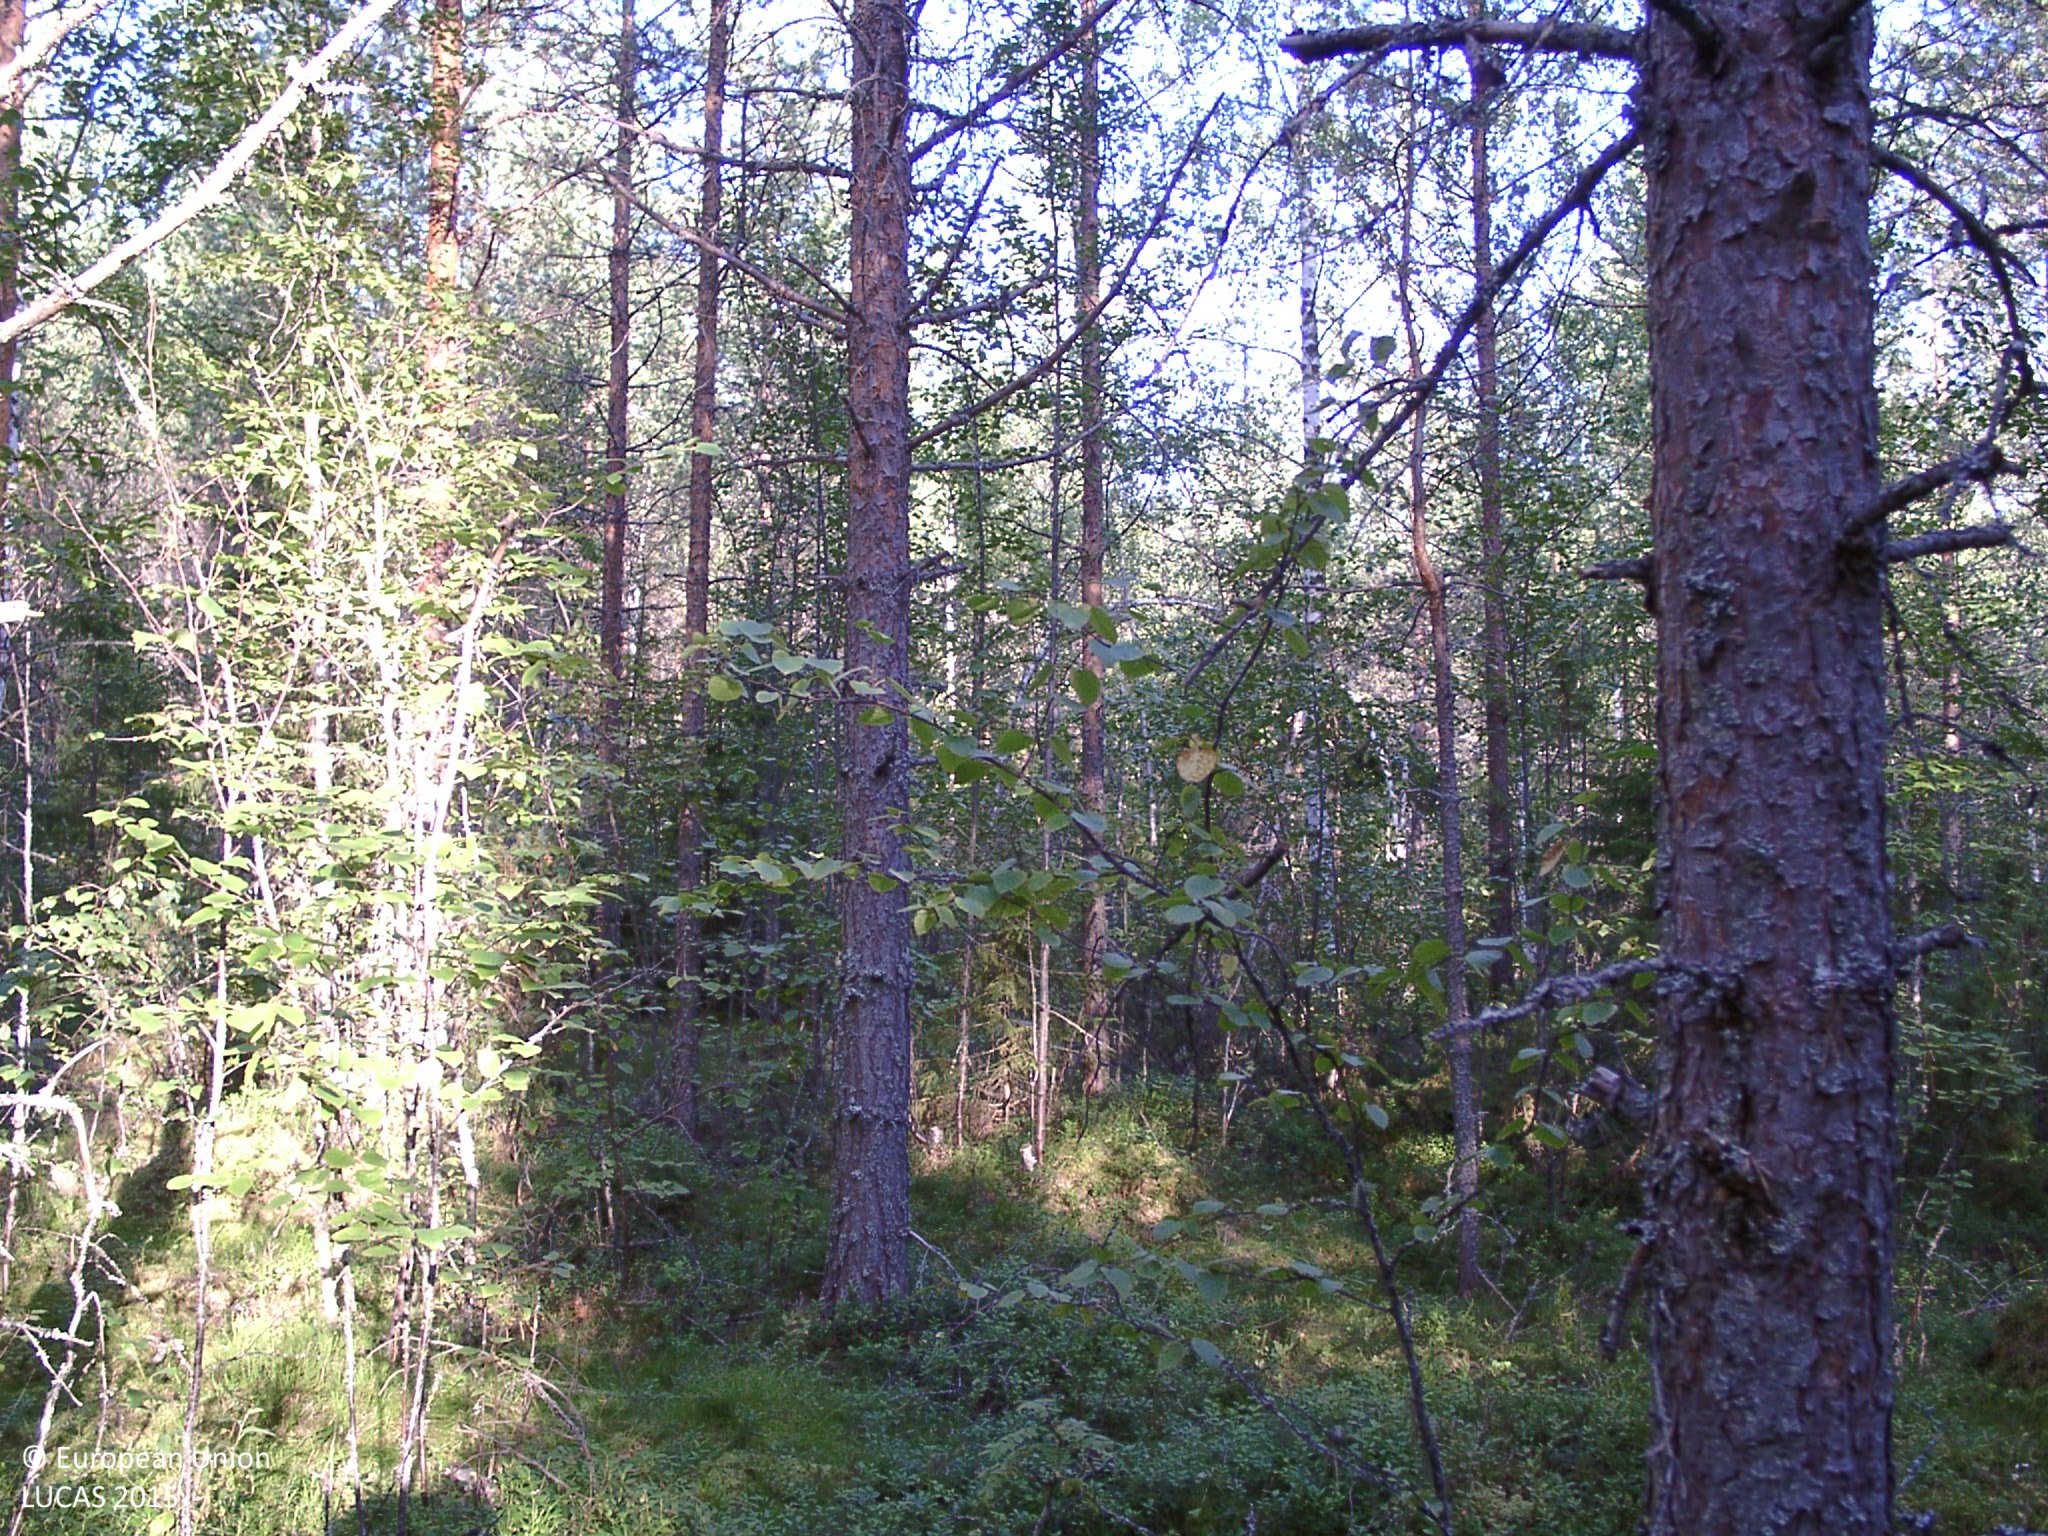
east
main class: Woodland
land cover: Pine dominated mixed woodland
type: boreal forest
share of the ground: 50 - 75 %
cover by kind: coniferous forest trees 50 %, broadleaved forest trees 20 %, shrubs 15 %, lichens and mosses 15 %
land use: Forestry
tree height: > 5 m
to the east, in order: Pine dominated mixed woodland; Pine dominated coniferous woodland; Other coniferous woodland; Tracks; Pine dominated coniferous woodland; Tracks; Pine dominated coniferous woodland; Tracks; Pine dominated coniferous woodland; Tracks
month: August
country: FI
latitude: 62.9115
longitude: 25.1178
